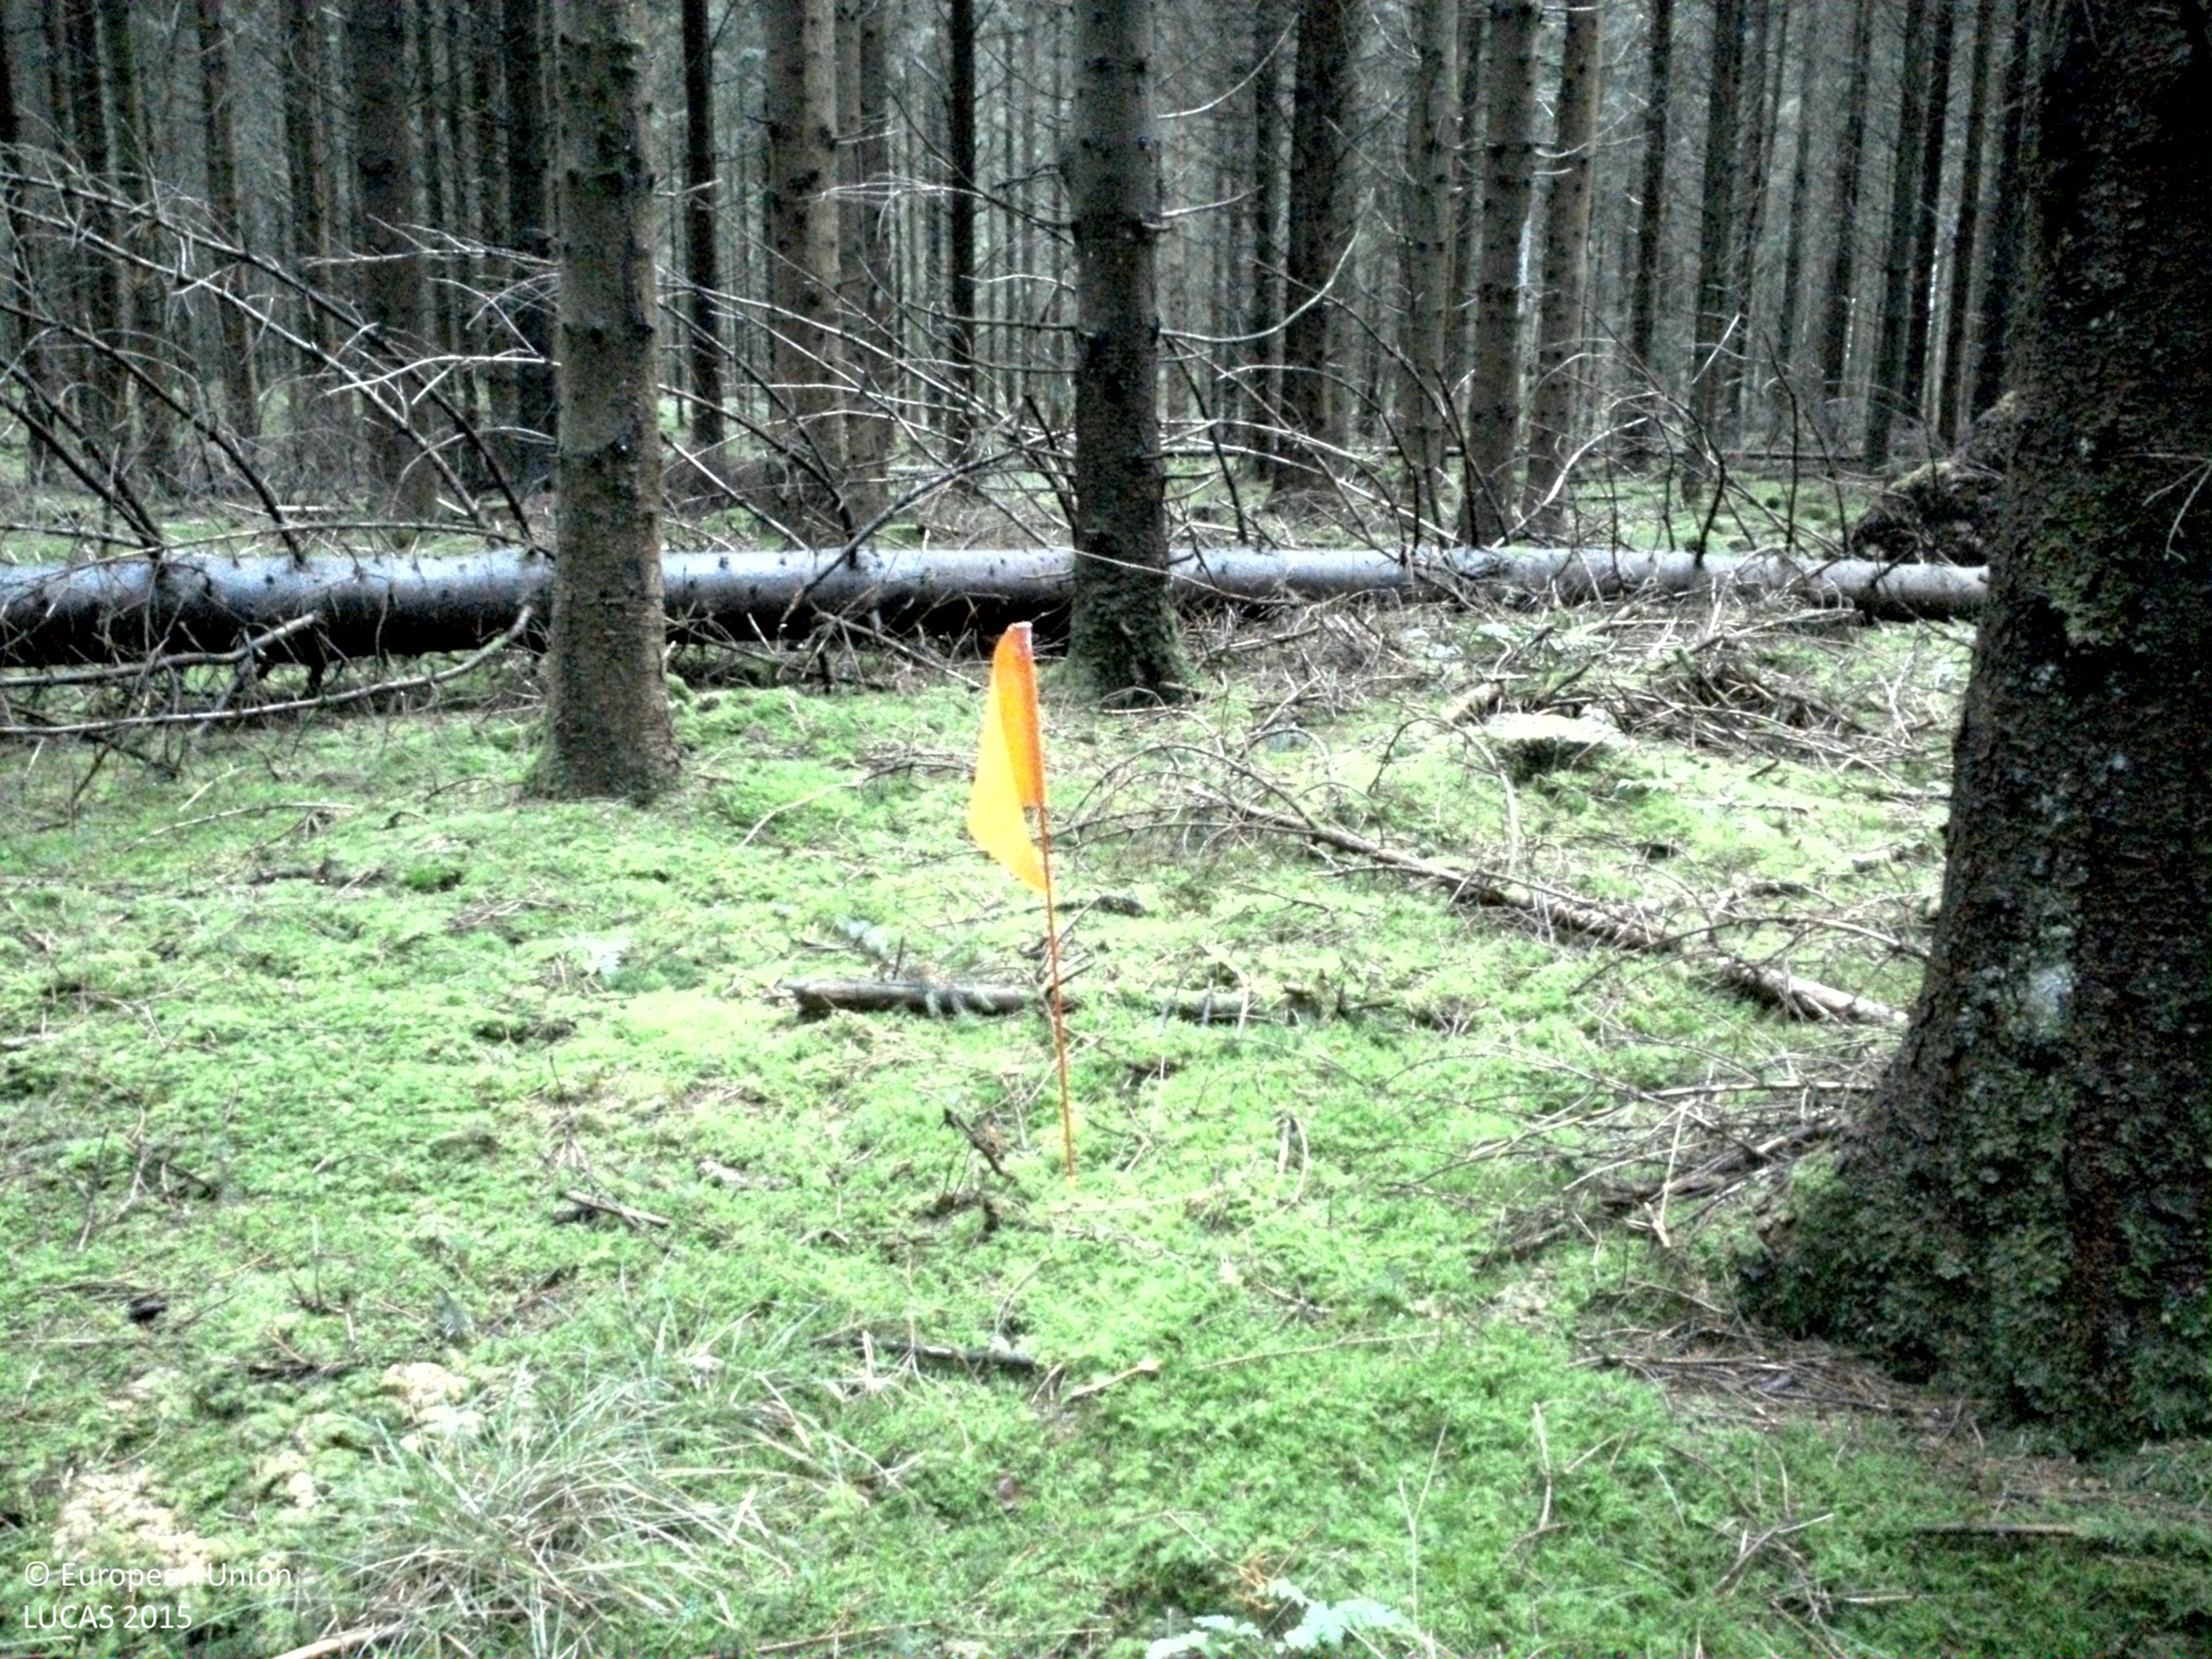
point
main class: Woodland
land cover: Spruce dominated coniferous woodland
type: hemiboreal forest and nemoral coniferous forest and mixed broadleaved-coniferous forest
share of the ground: > 75 %
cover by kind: coniferous forest trees 85 %, lichens and mosses 10 %, herbaceous plants 5 %
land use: Forestry
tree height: > 5 m
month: November
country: SE
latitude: 56.2385
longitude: 13.1758
